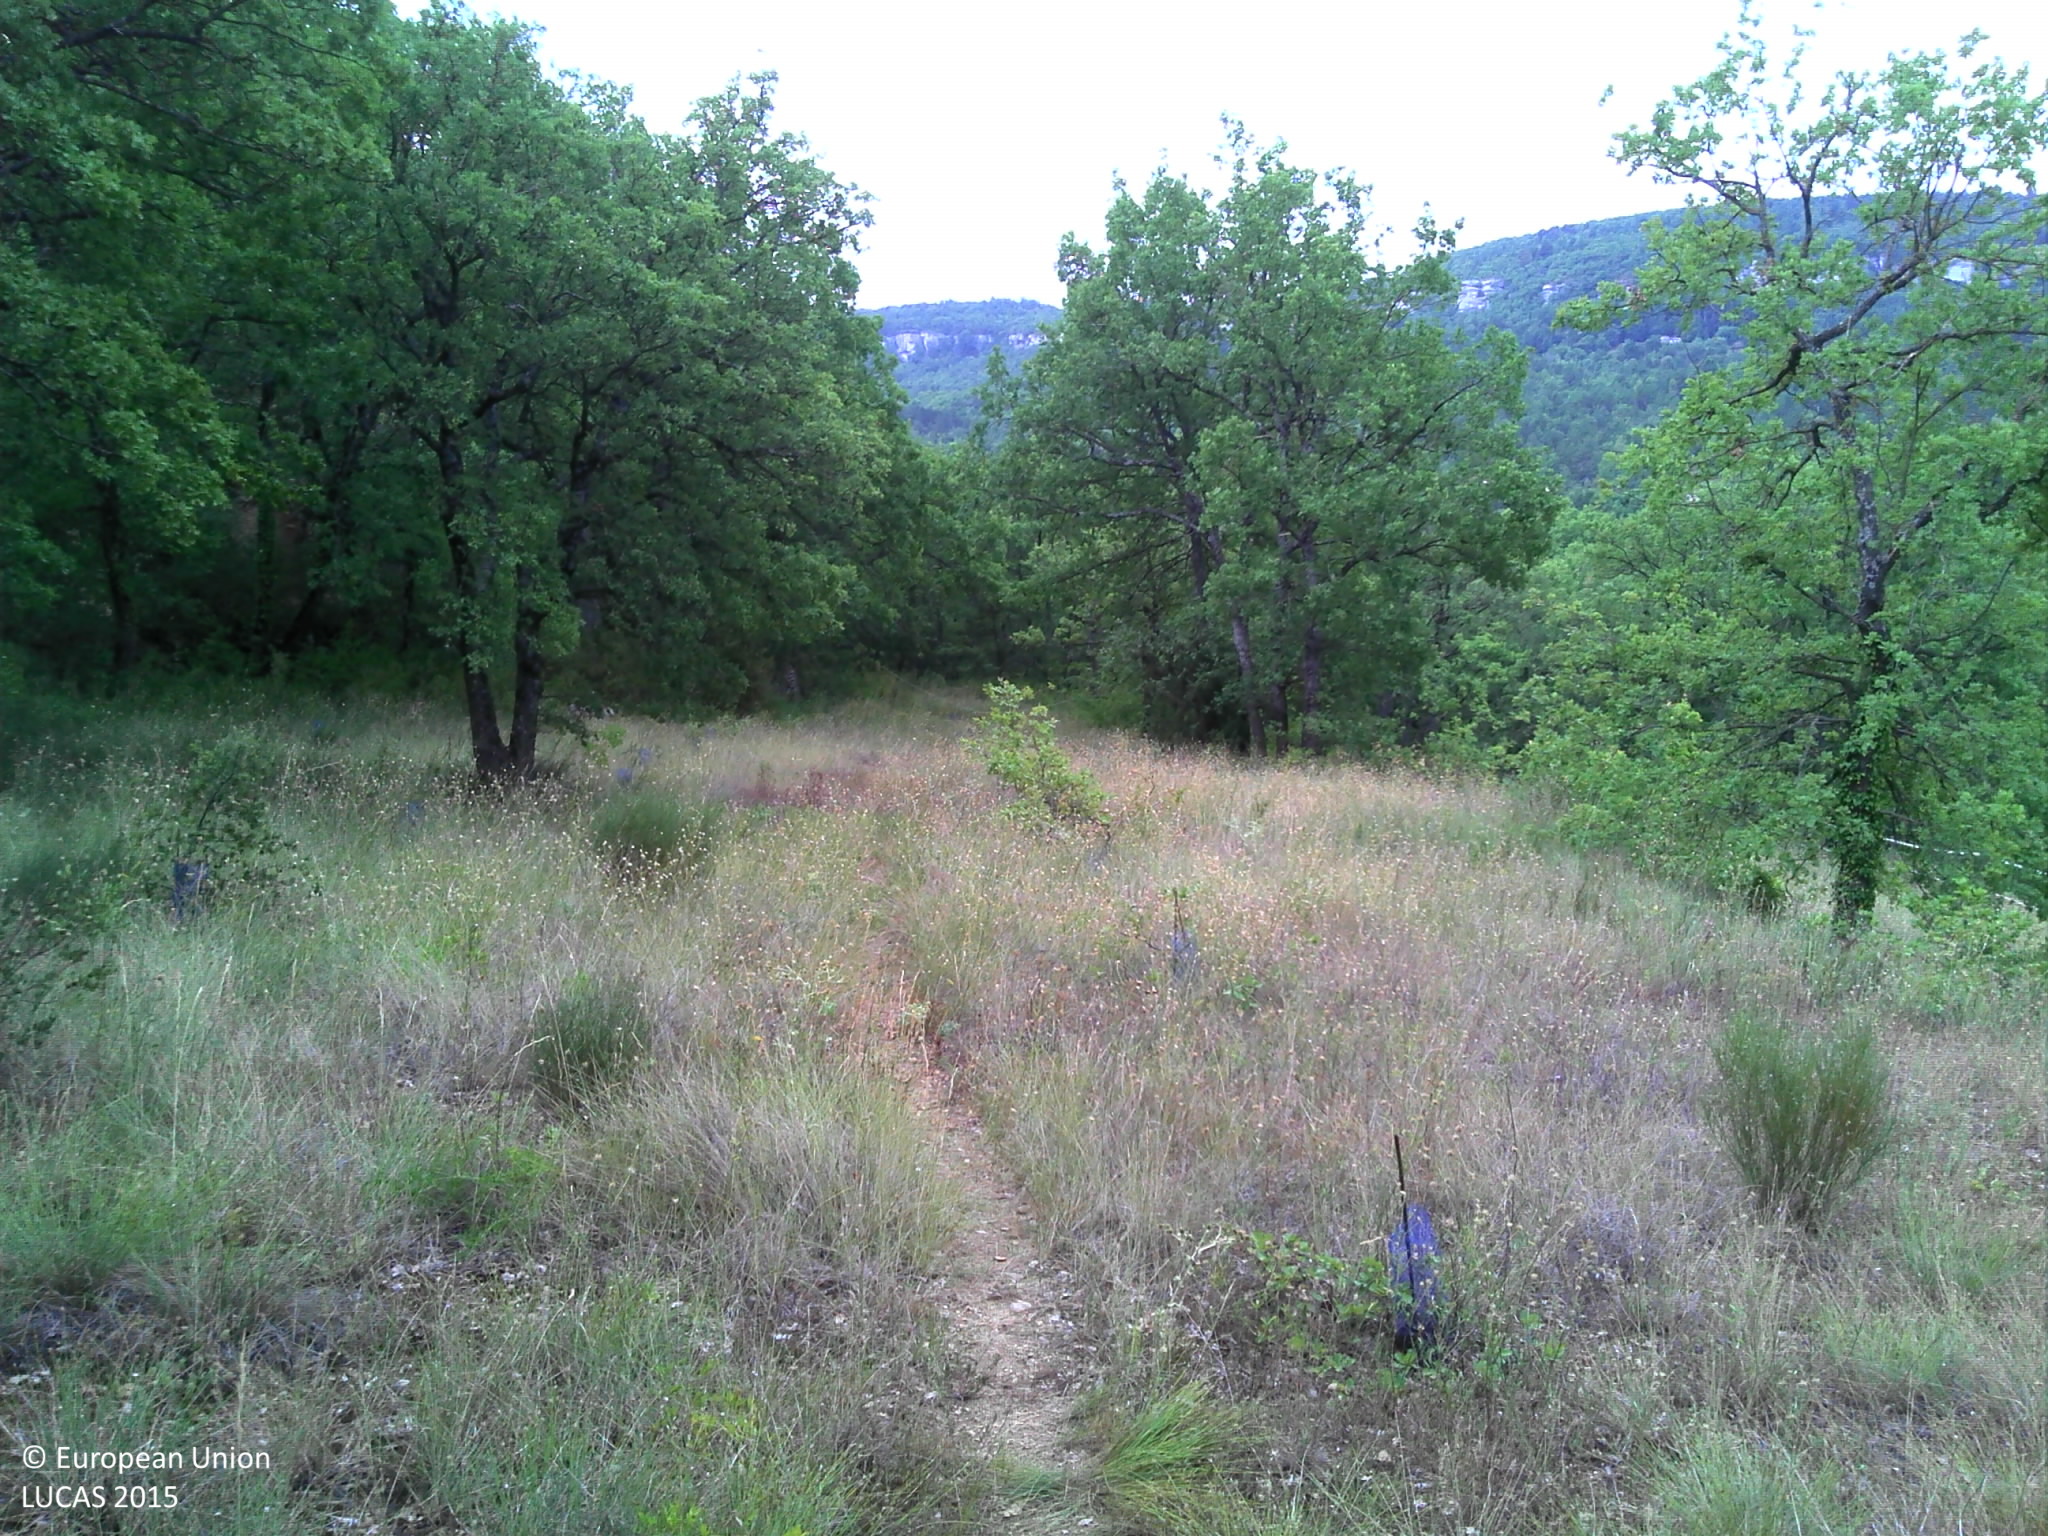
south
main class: Woodland
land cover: Broadleaved woodland
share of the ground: < 10 %
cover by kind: herbaceous plants 90 %, broadleaved forest trees 10 %
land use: Forestry
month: August
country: FR
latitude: 43.8700
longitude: 5.4170
